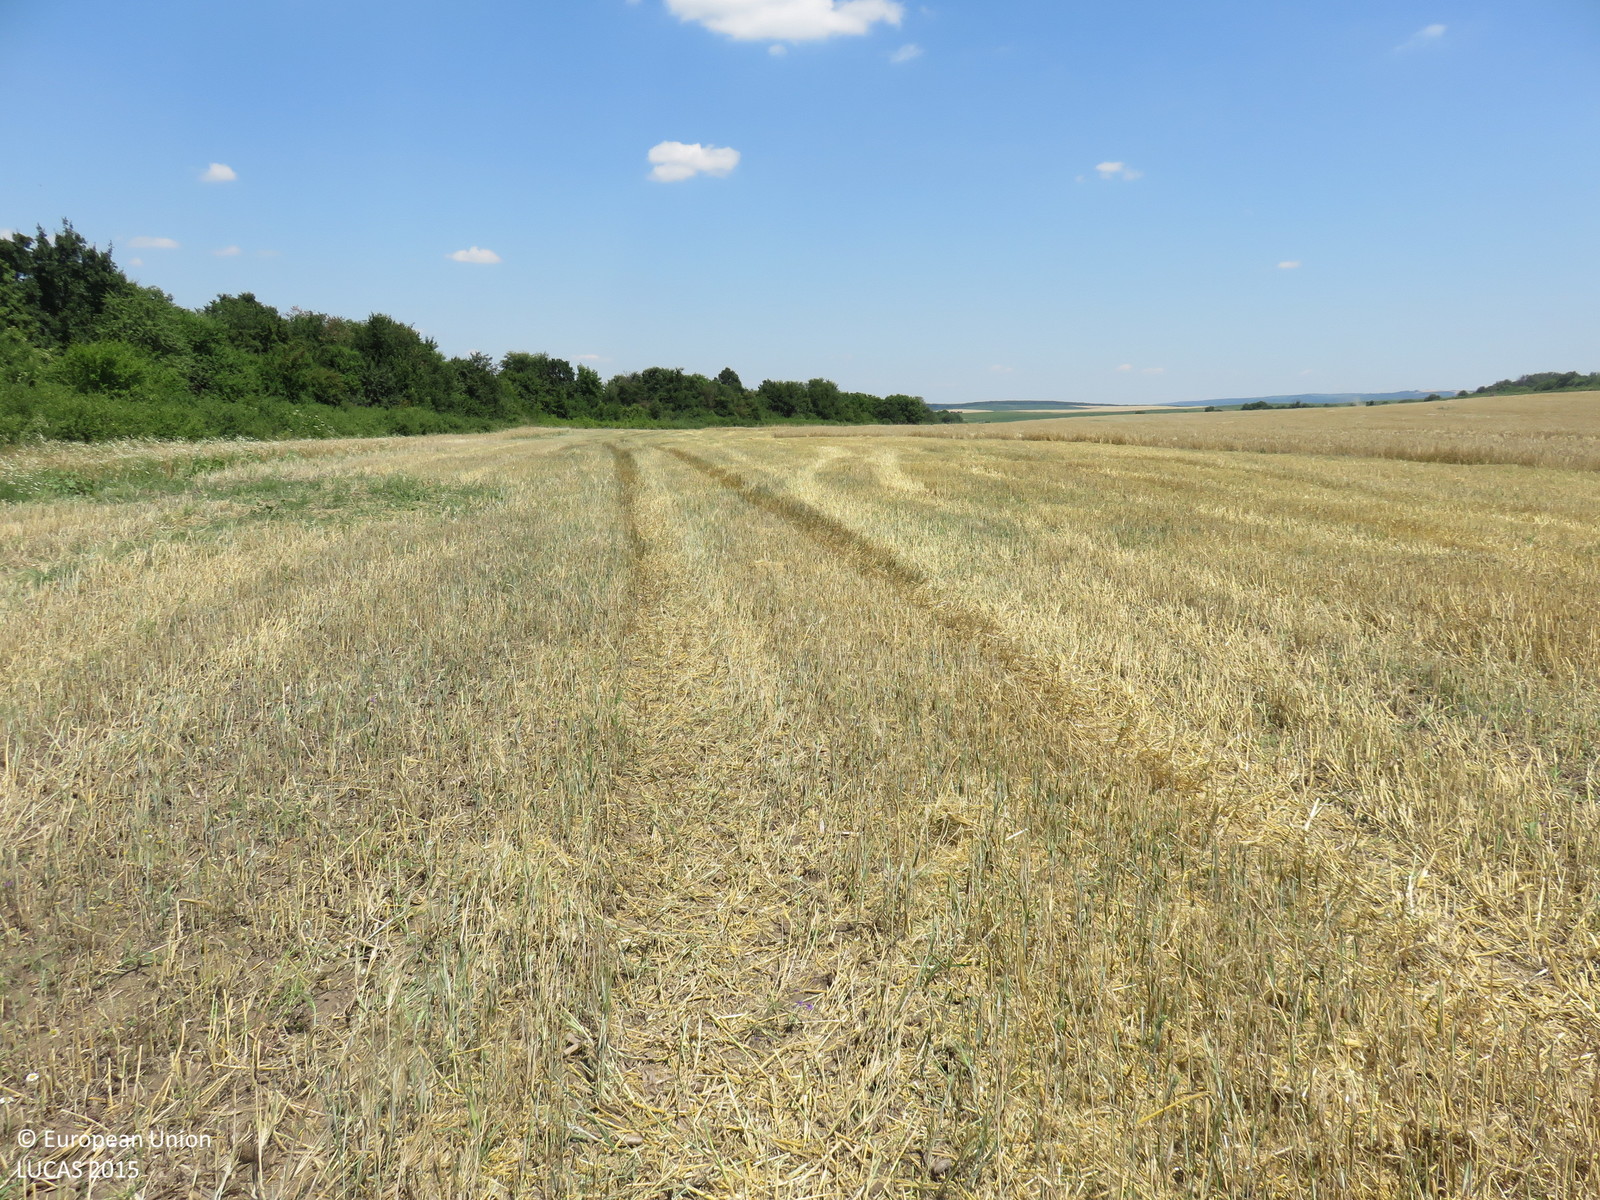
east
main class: Cropland
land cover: Barley
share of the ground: > 75 %
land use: Agriculture (excluding fallow land and kitchen gardens)
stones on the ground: < 10 %
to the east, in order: Barley
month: June
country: BG
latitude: 43.2588
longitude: 24.8354
